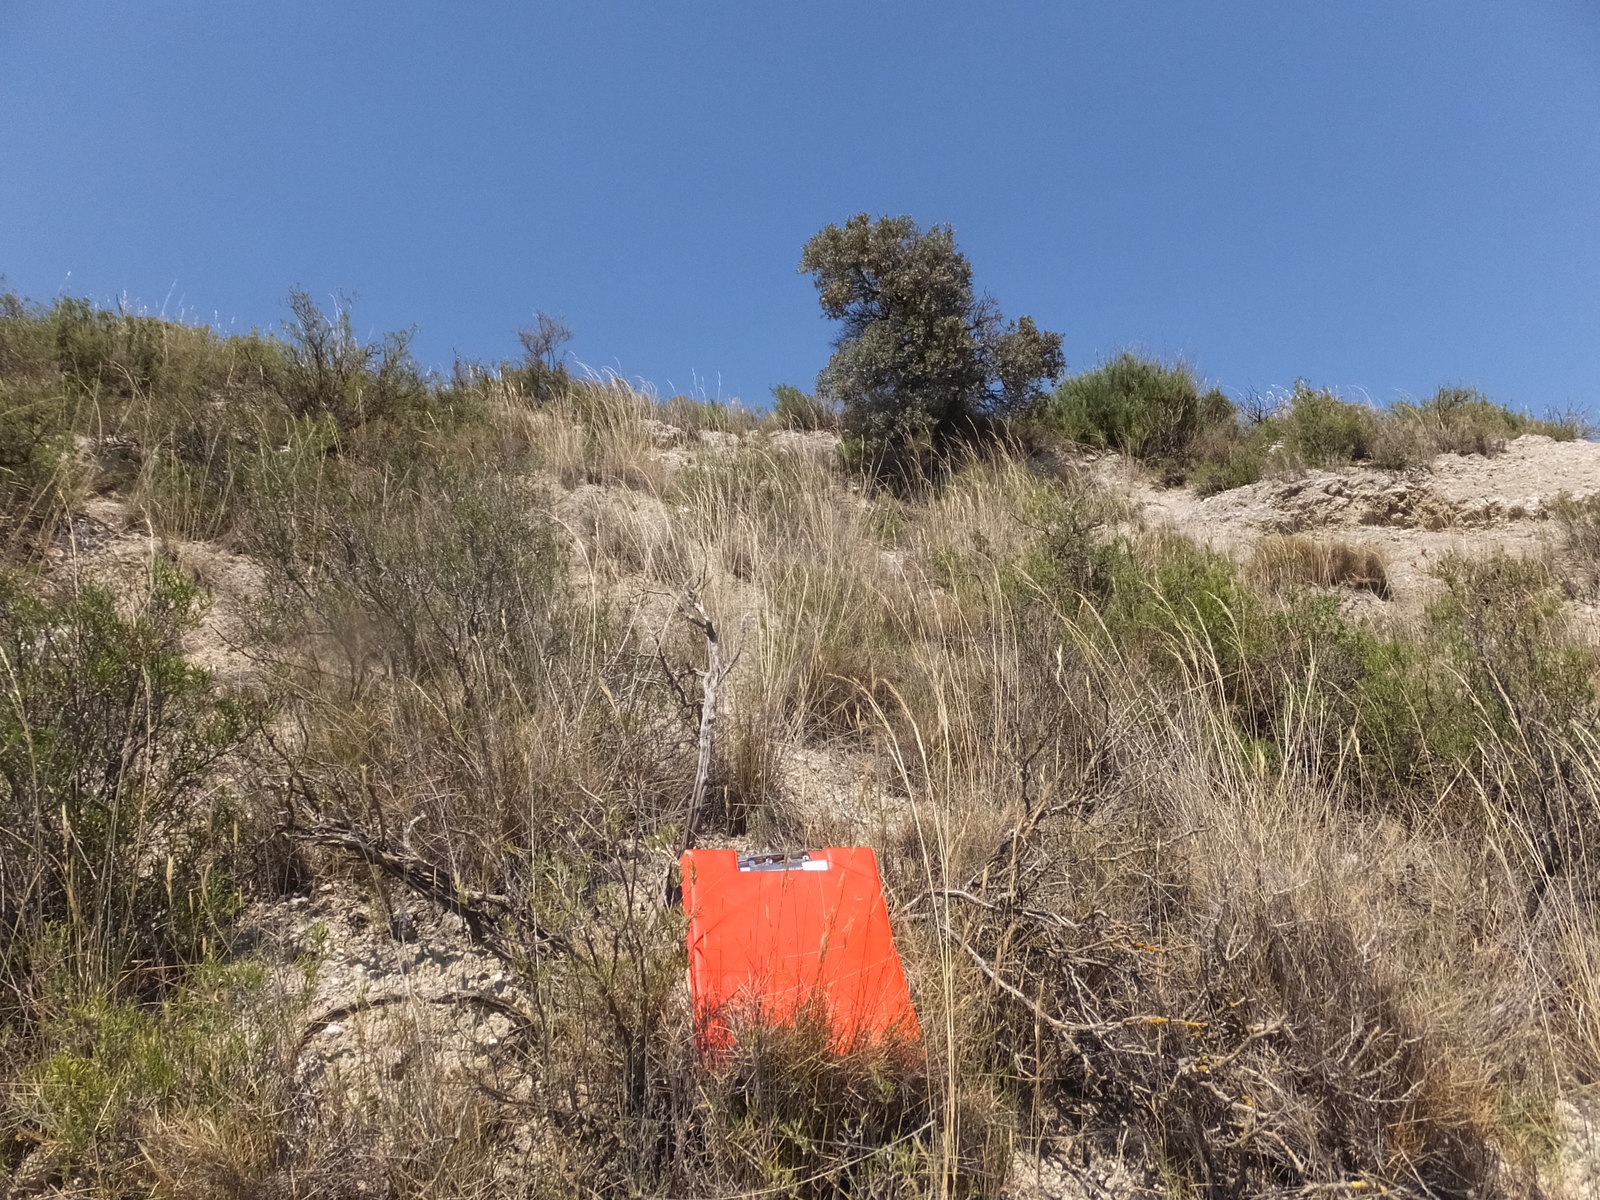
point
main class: Shrubland
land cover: Shrubland with sparse tree cover
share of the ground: 50 - 75 %
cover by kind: shrubs 50 %, herbaceous plants 25 %, consolidated bare surface 20 %, coniferous forest trees 5 %
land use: Semi-natural and natural areas not in use
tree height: < 5 m
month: June
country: ES
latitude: 41.8617
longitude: 0.5044
